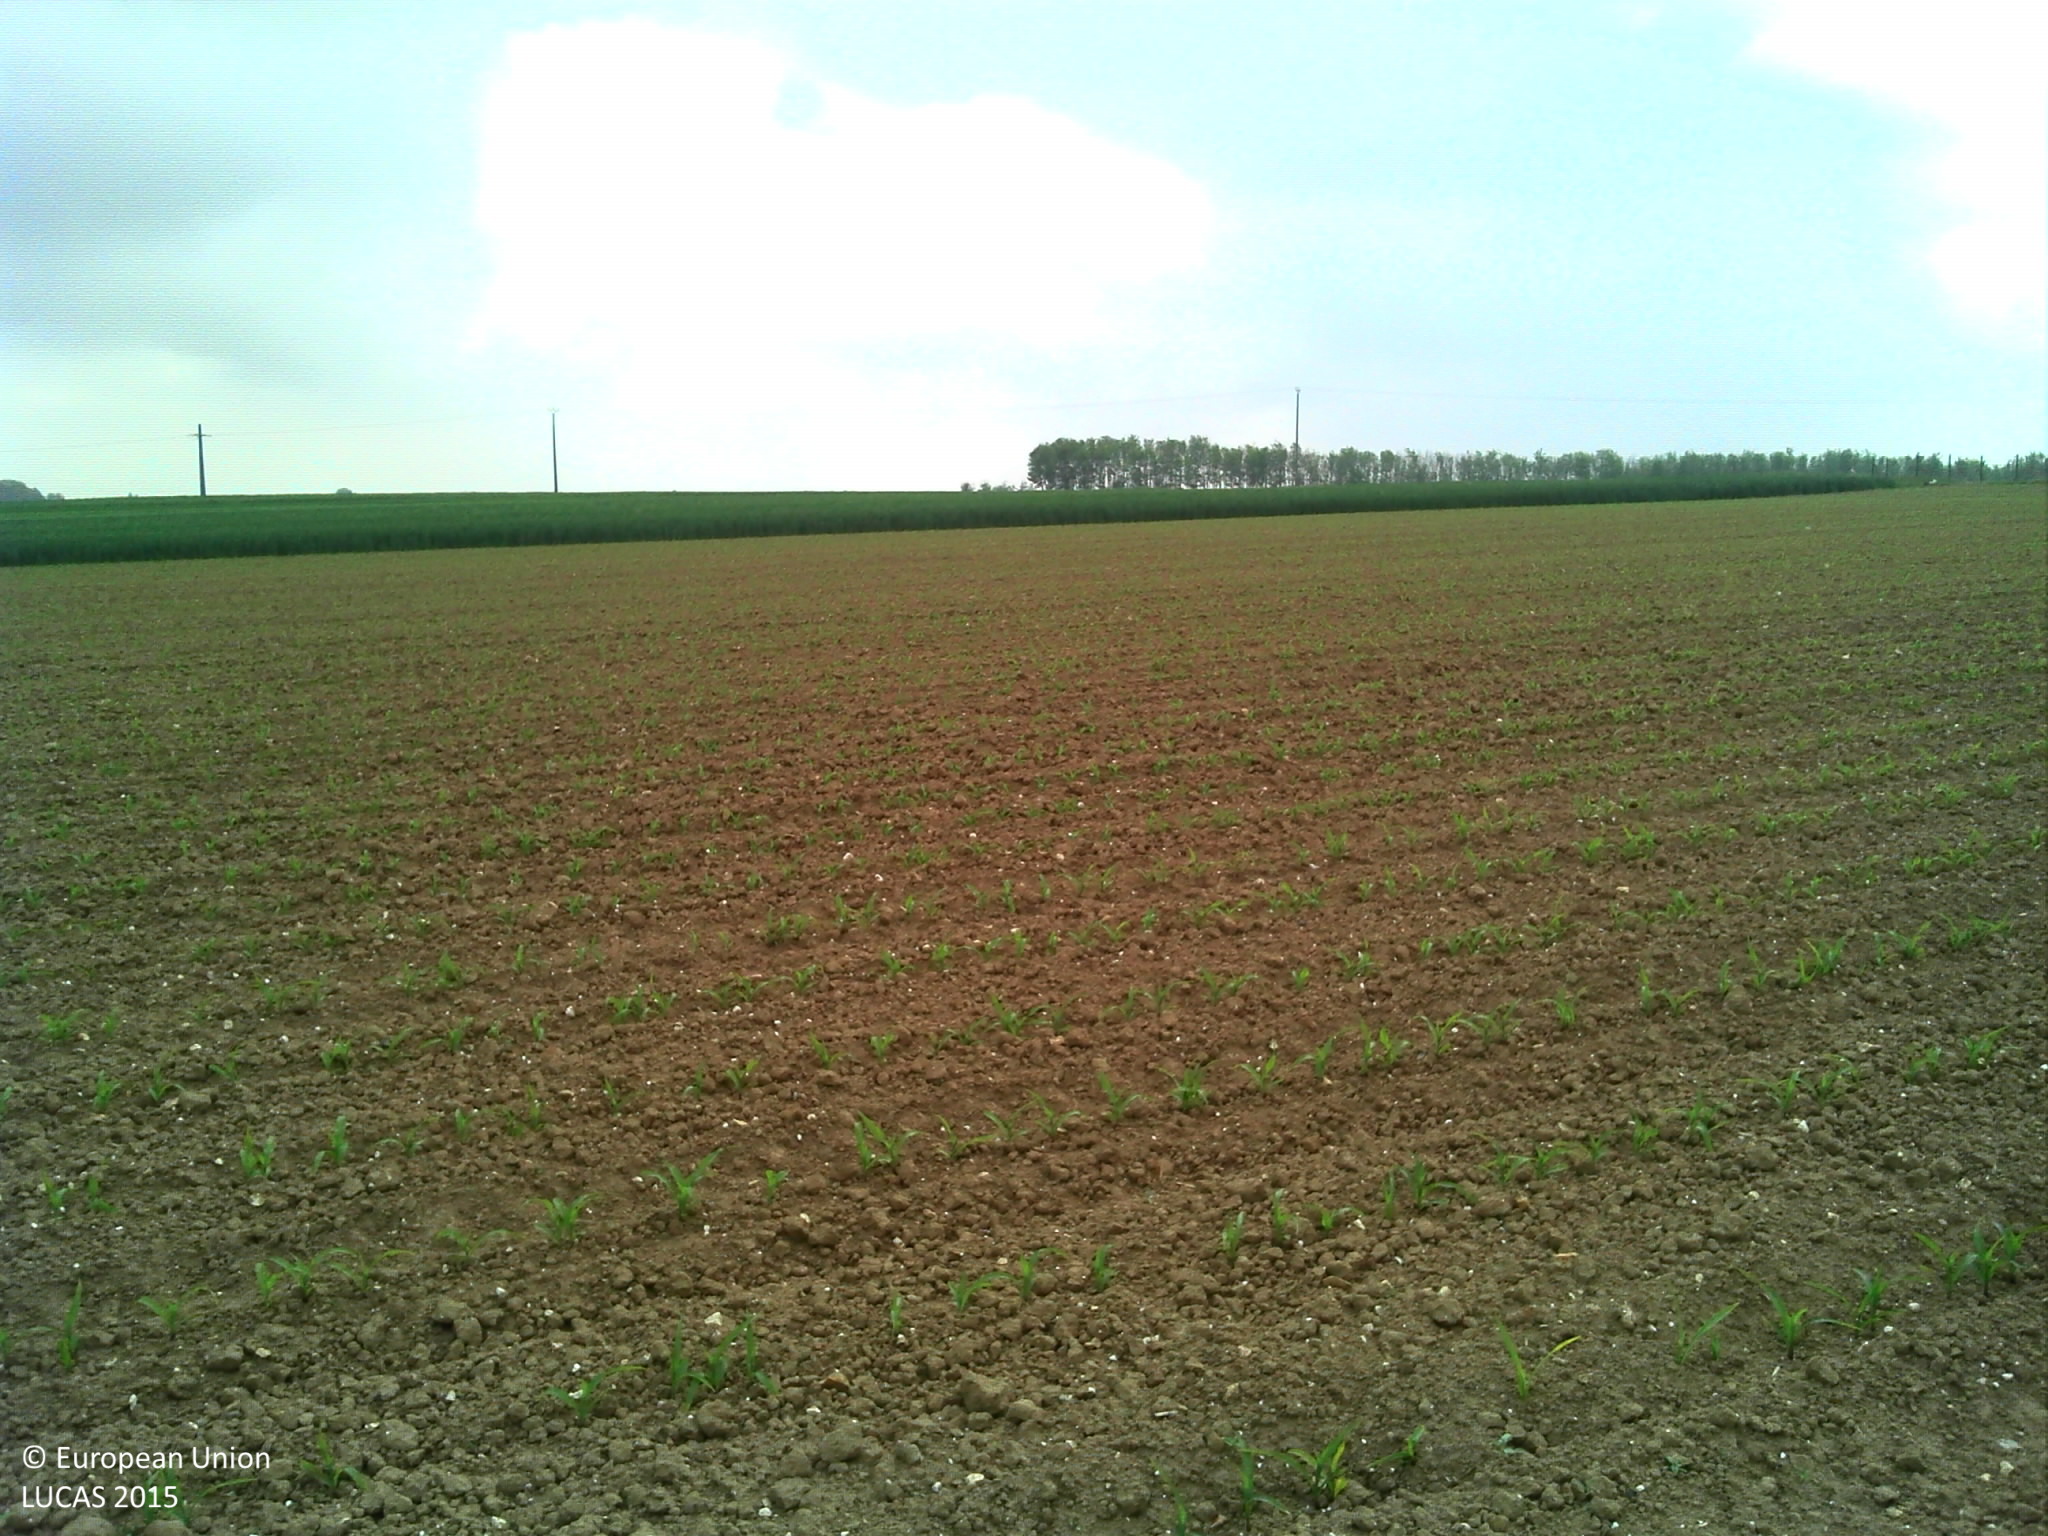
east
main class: Cropland
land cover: Maize
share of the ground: 10 - 25 %
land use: Agriculture (excluding fallow land and kitchen gardens)
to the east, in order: Maize; Common wheat; Temporary grasslands; Electric lines; Common wheat
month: May
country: FR
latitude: 50.6486
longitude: 2.3350
